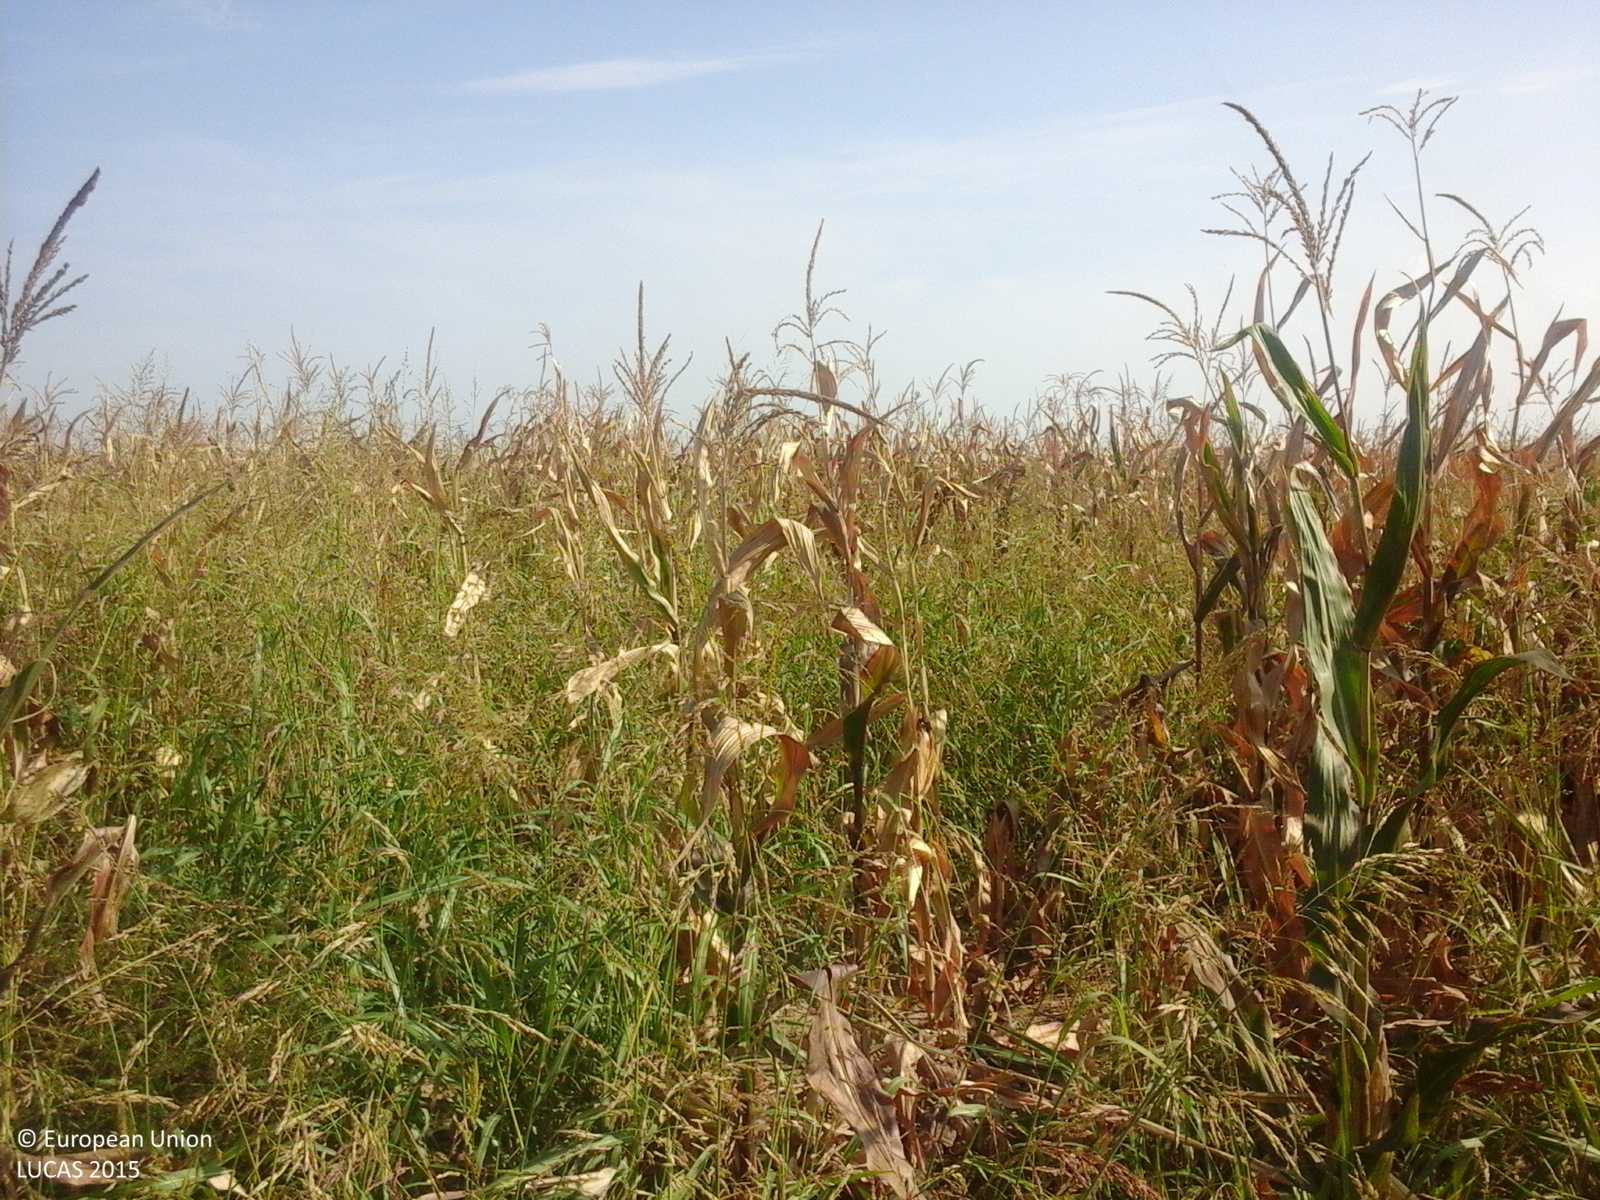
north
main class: Cropland
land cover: Maize
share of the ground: 50 - 75 %
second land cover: Spontaneously vegetated surfaces
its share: 50 - 75 %
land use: Agriculture (excluding fallow land and kitchen gardens)
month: August
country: RO
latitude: 43.8481
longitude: 23.4944
